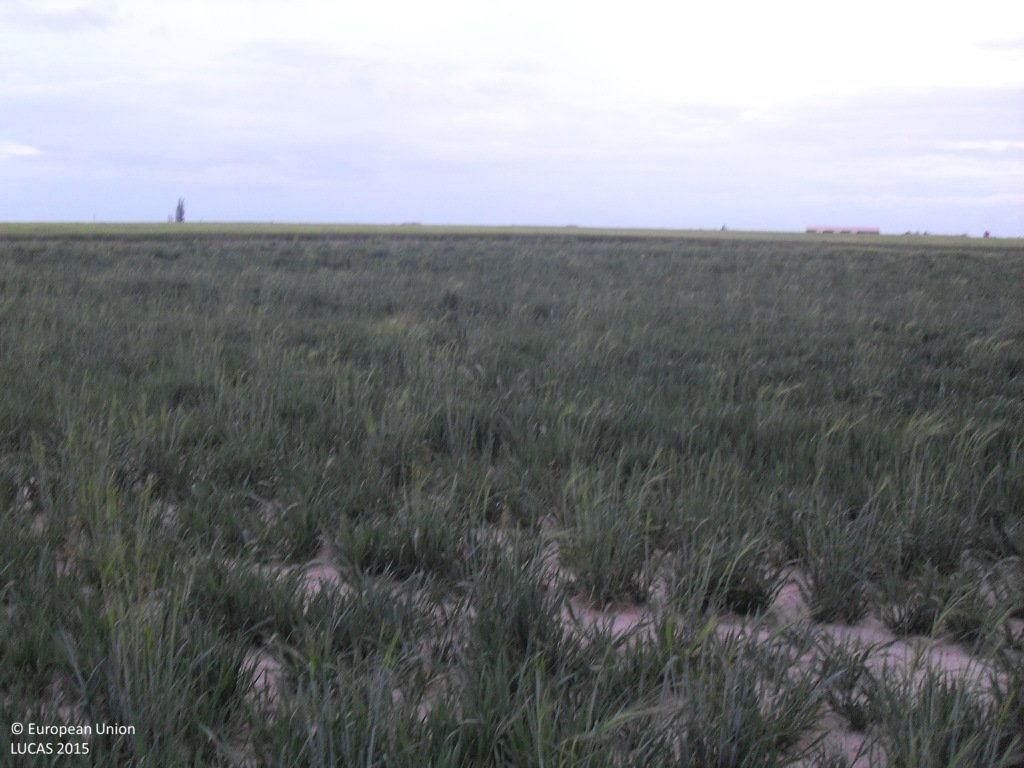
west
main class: Cropland
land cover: Oats
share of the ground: > 75 %
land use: Agriculture (excluding fallow land and kitchen gardens)
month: April
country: ES
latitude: 40.9781
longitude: -5.2461
